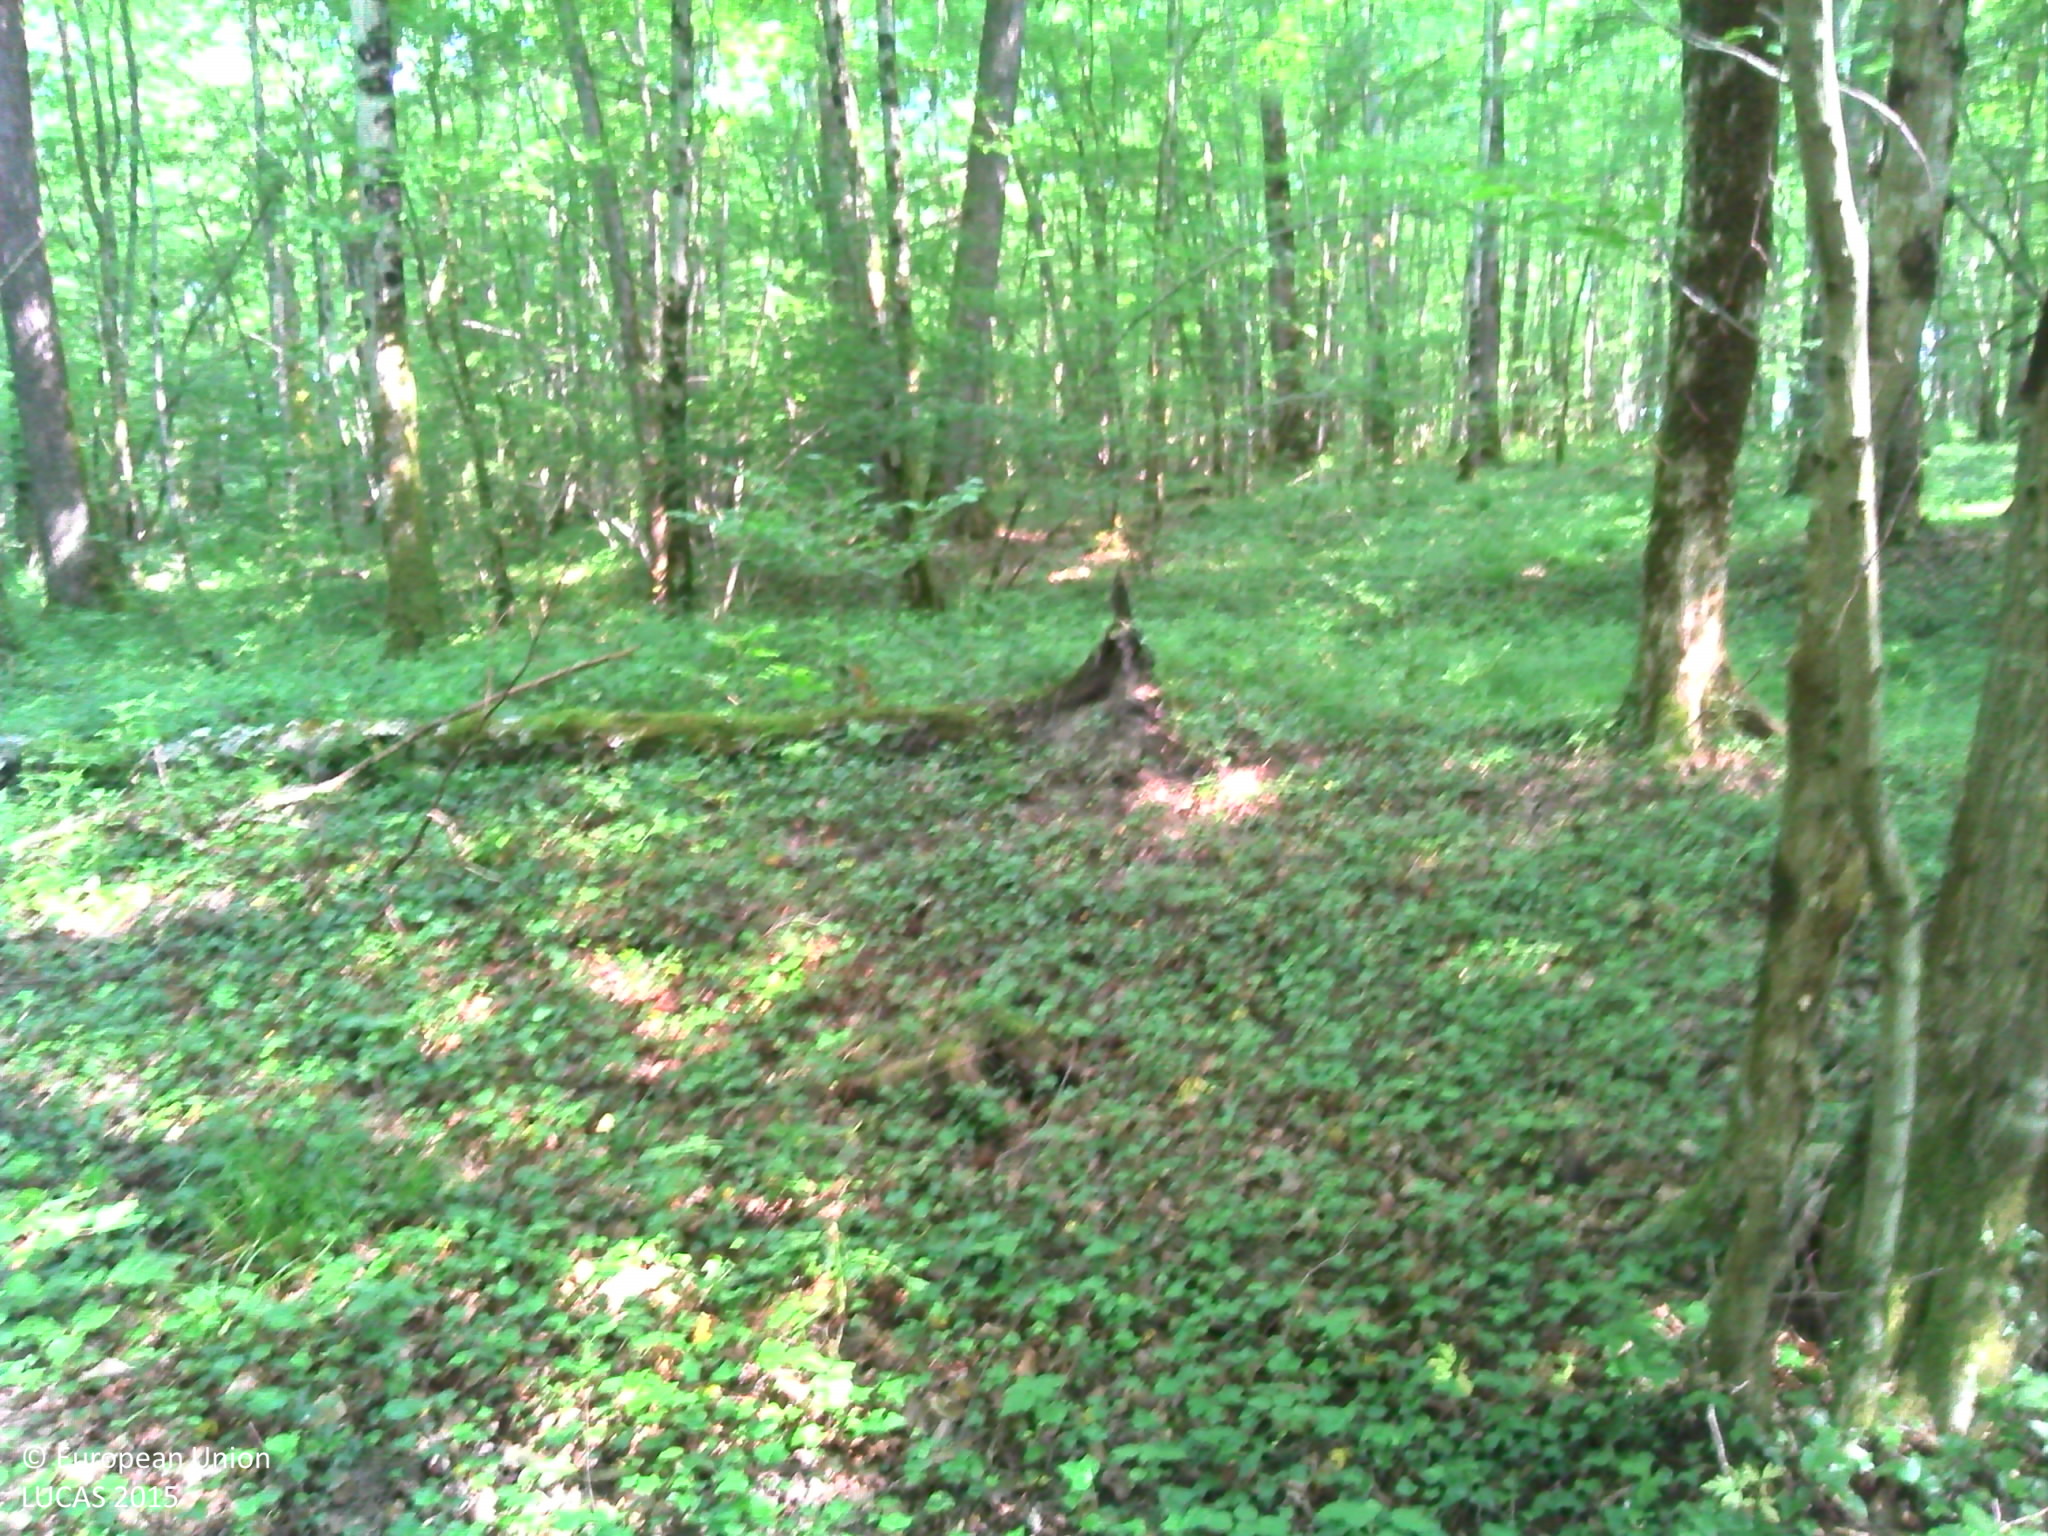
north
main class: Woodland
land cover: Broadleaved woodland
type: beech forest
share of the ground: > 75 %
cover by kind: broadleaved forest trees 95 %, herbaceous plants 5 %
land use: Forestry
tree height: > 5 m
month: June
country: FR
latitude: 47.8676
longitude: 6.1374
